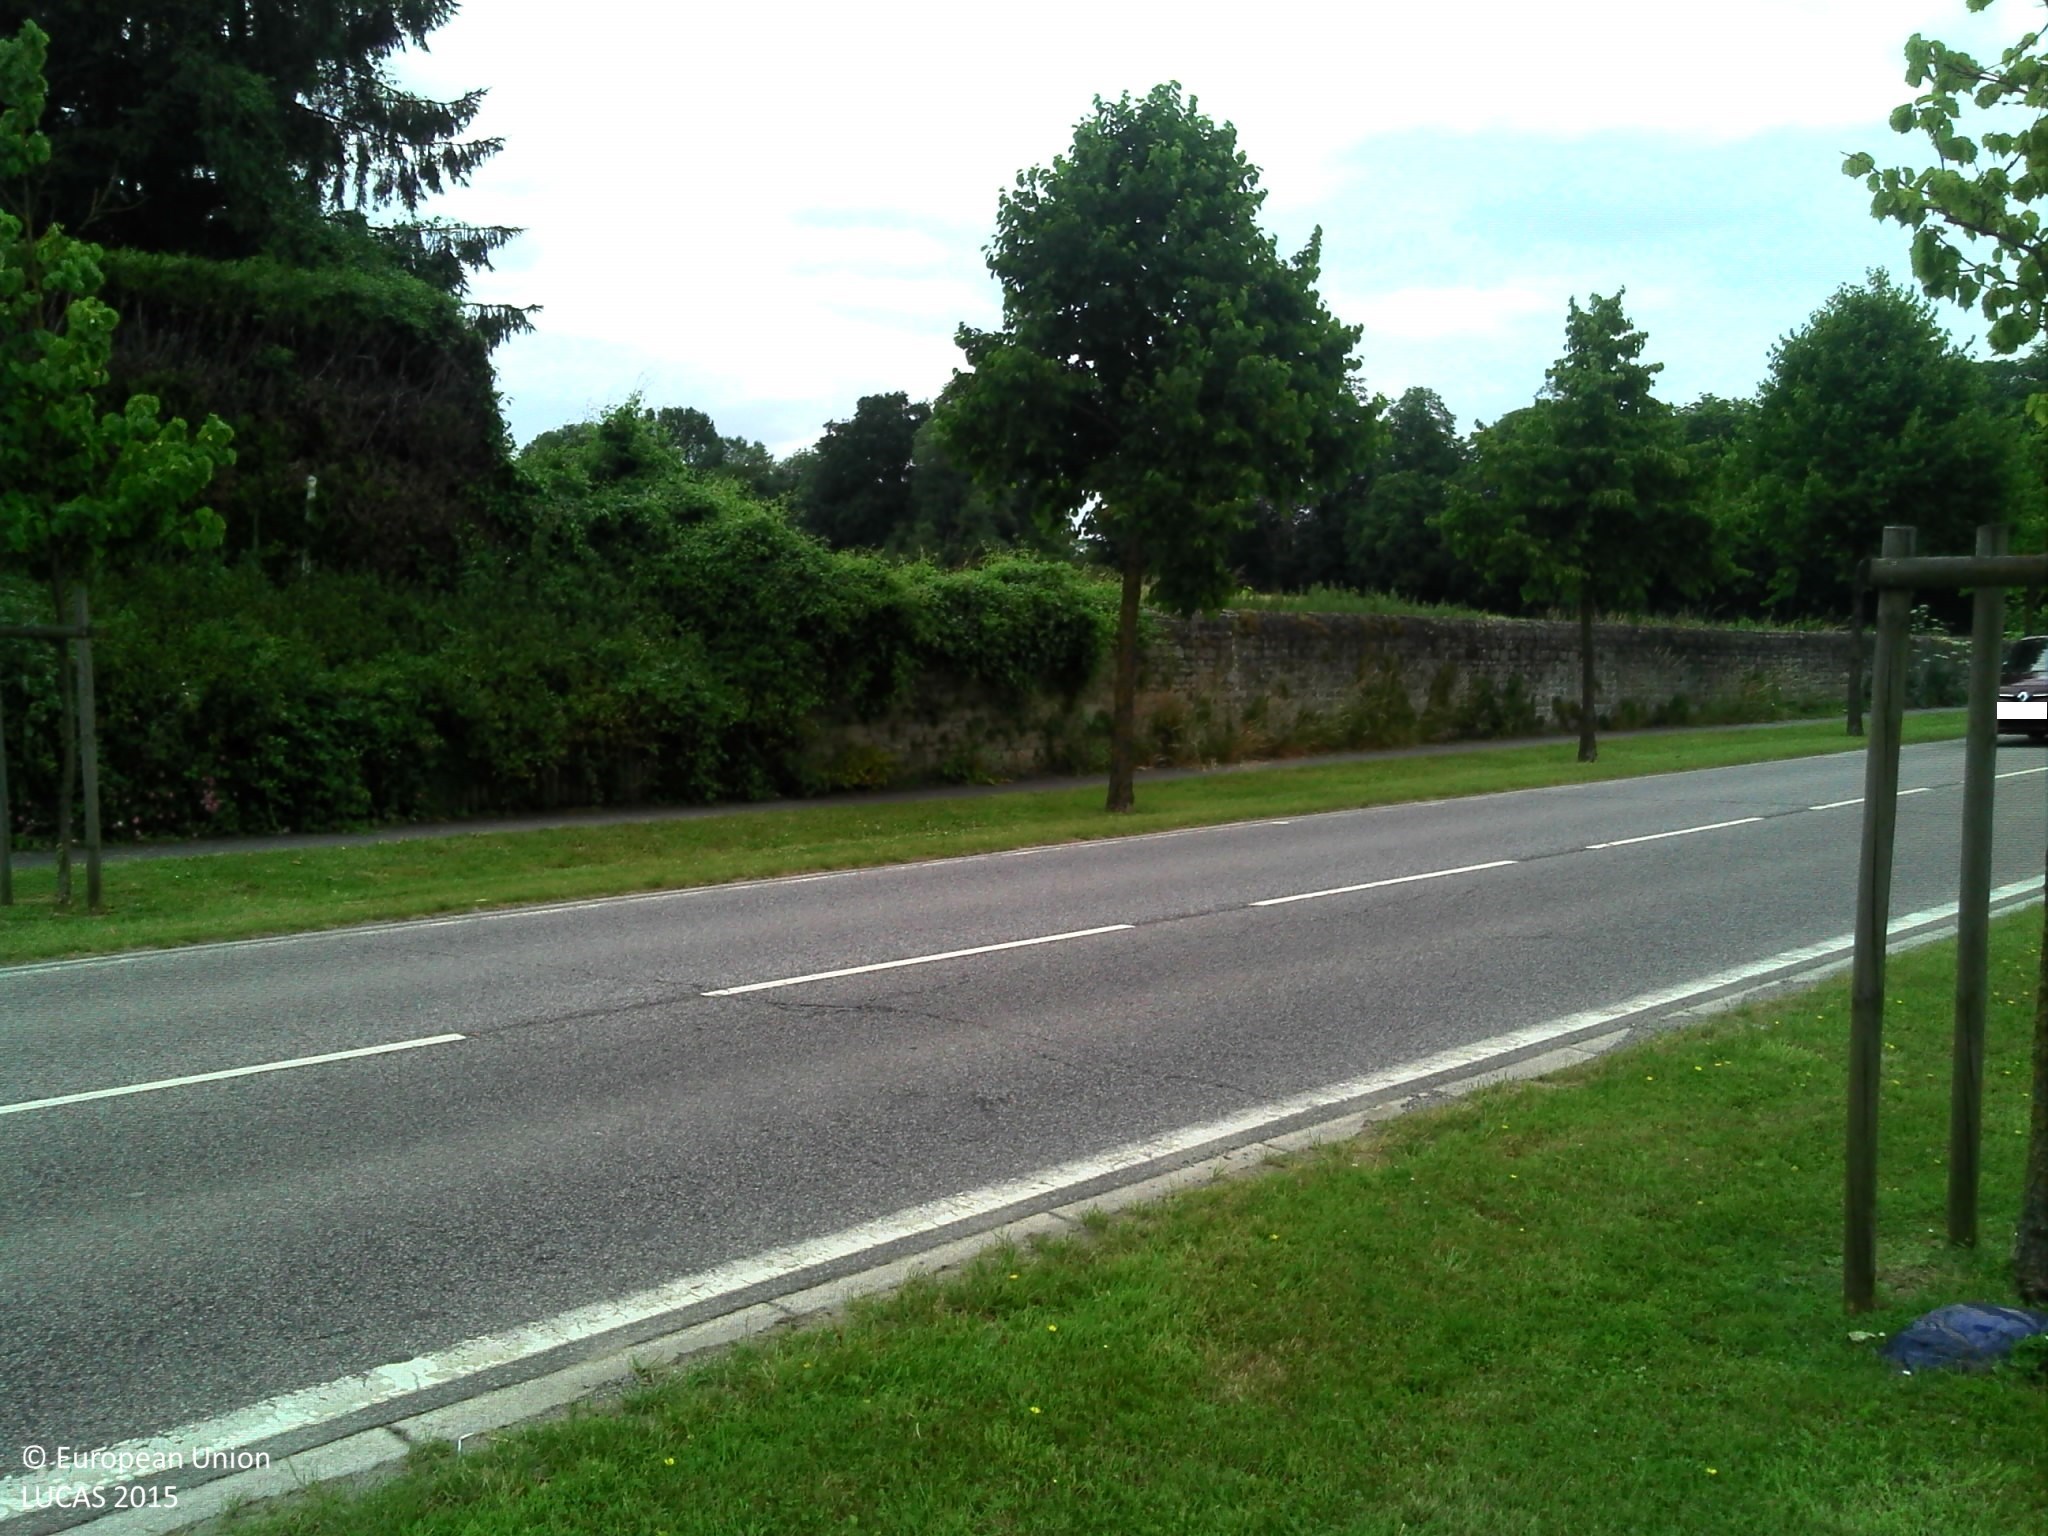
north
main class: Grassland
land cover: Grassland with sparse tree/shrub cover
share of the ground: > 75 %
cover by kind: herbaceous plants 95 %, broadleaved forest trees 5 %
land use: Road transport
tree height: < 5 m
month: June
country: FR
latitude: 48.4490
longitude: 0.1155
